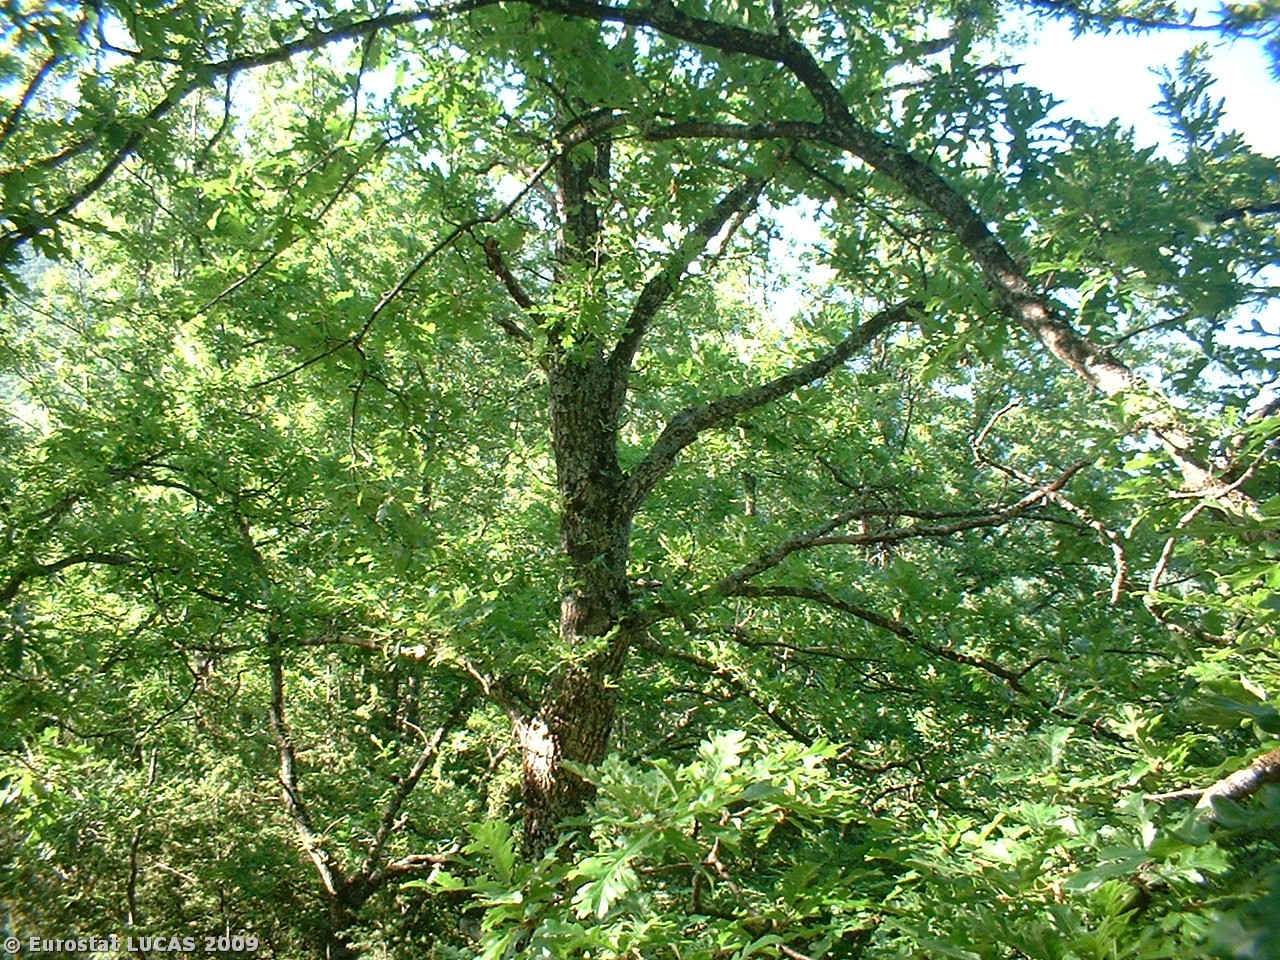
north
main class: Woodland
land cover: Broadleaved woodland
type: mesophytic deciduous forest
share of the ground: > 75 %
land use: Forestry
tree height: > 5 m
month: June
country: IT
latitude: 42.7284
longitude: 13.2512
